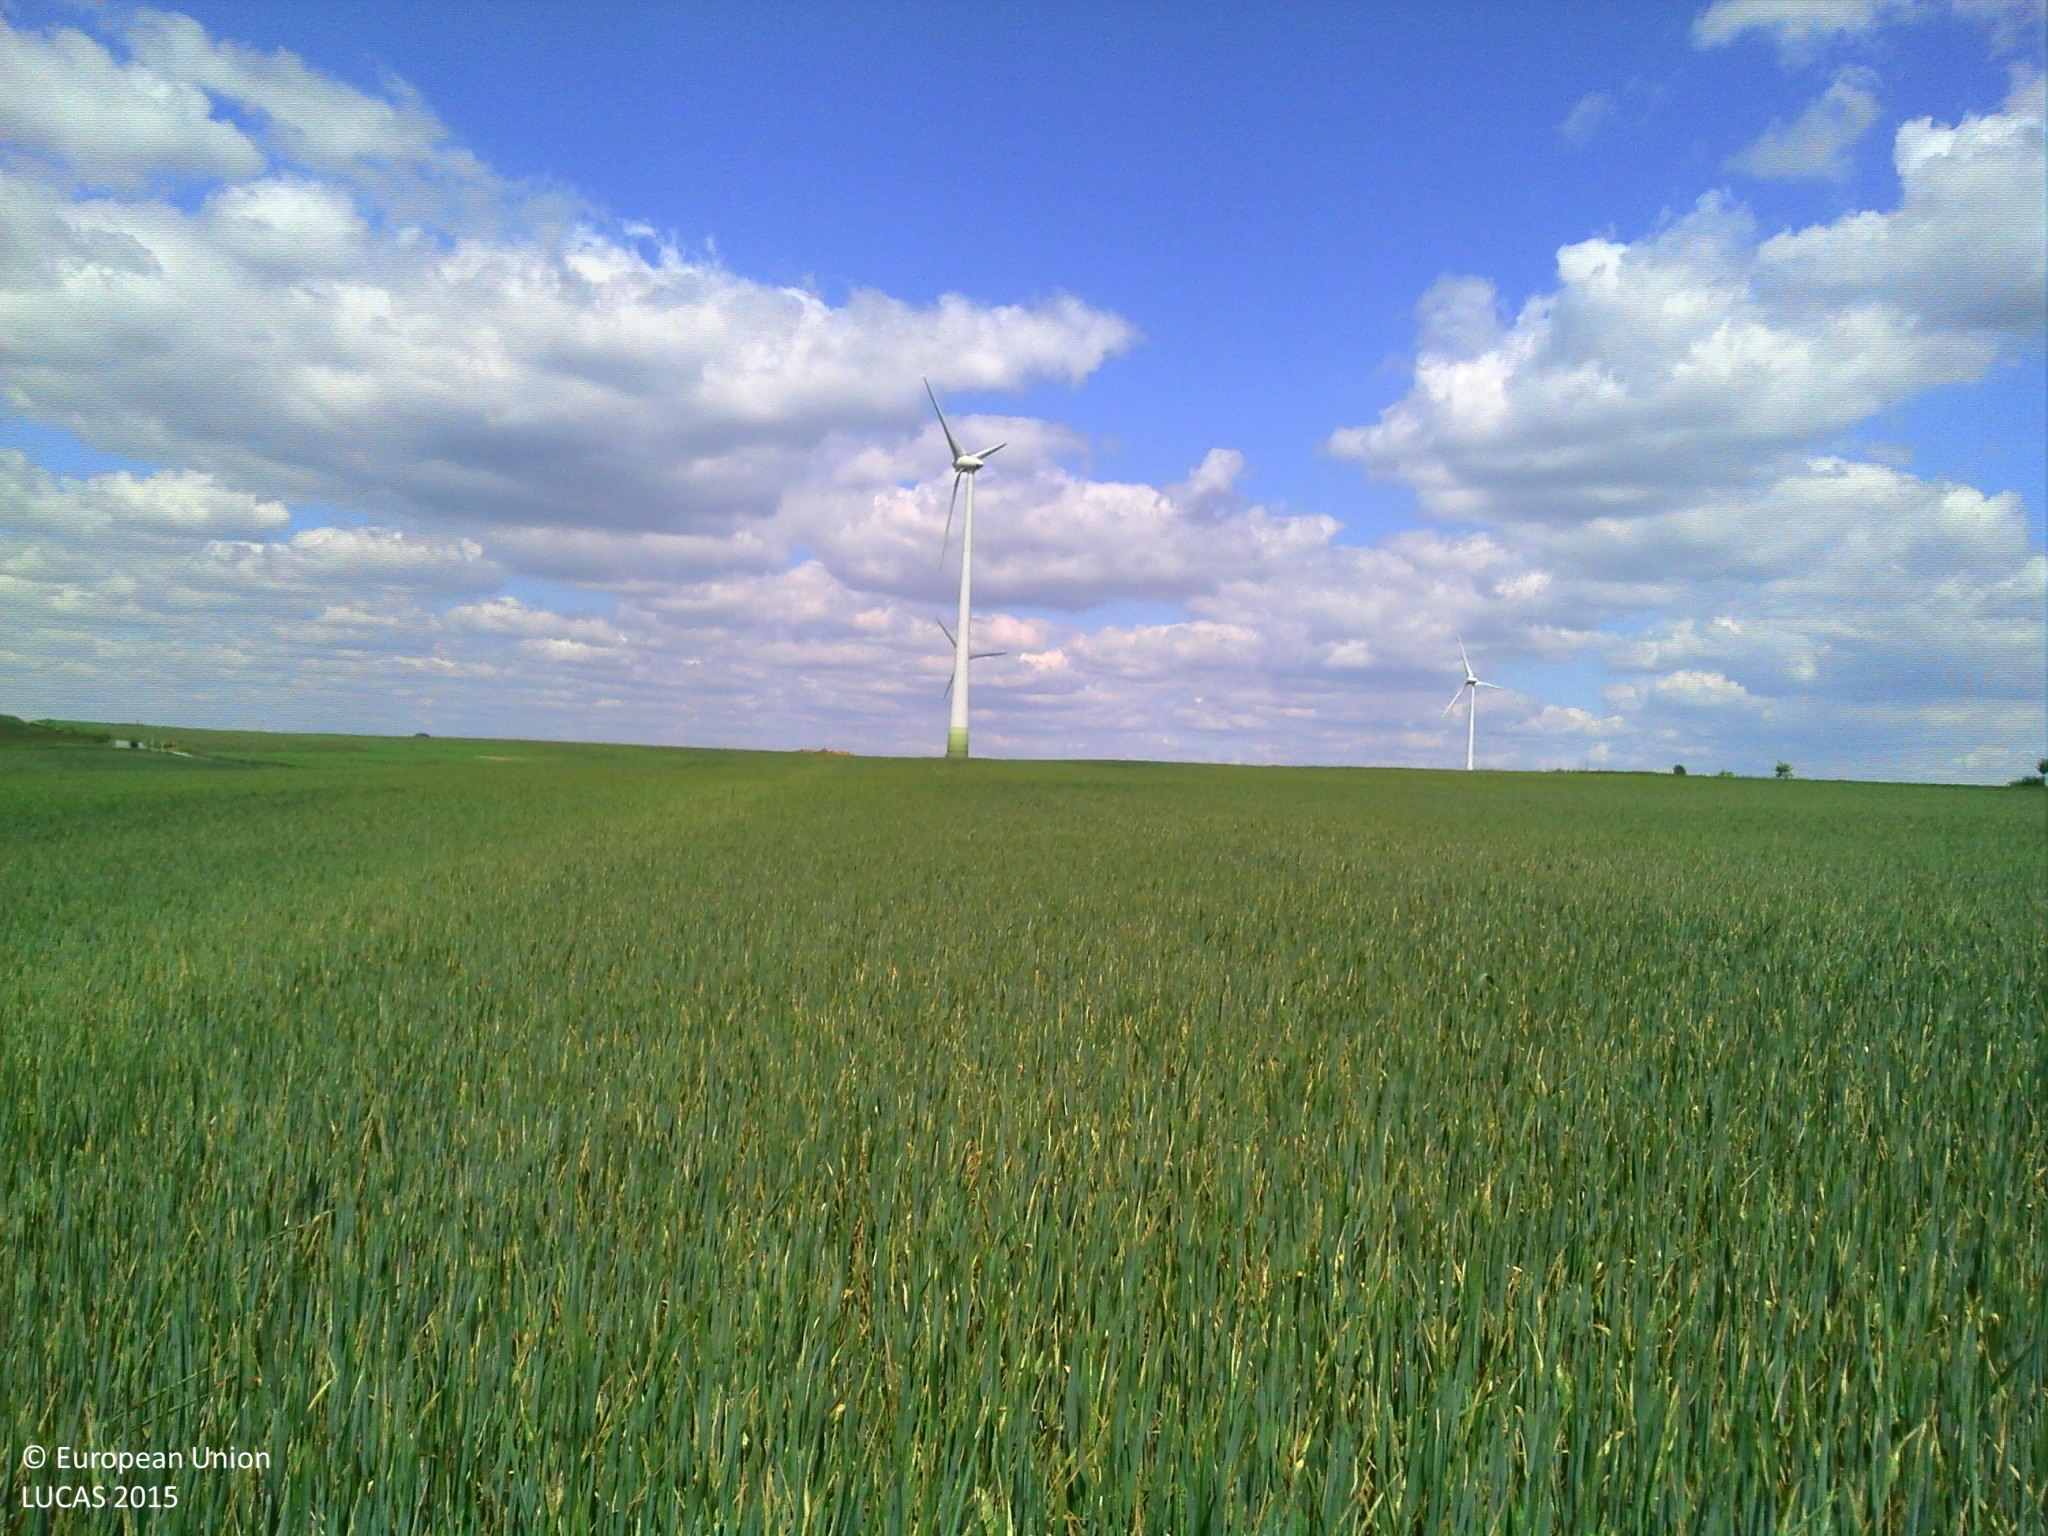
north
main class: Cropland
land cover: Common wheat
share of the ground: > 75 %
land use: Agriculture (excluding fallow land and kitchen gardens)
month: May
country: LU
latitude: 49.7522
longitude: 6.4882
